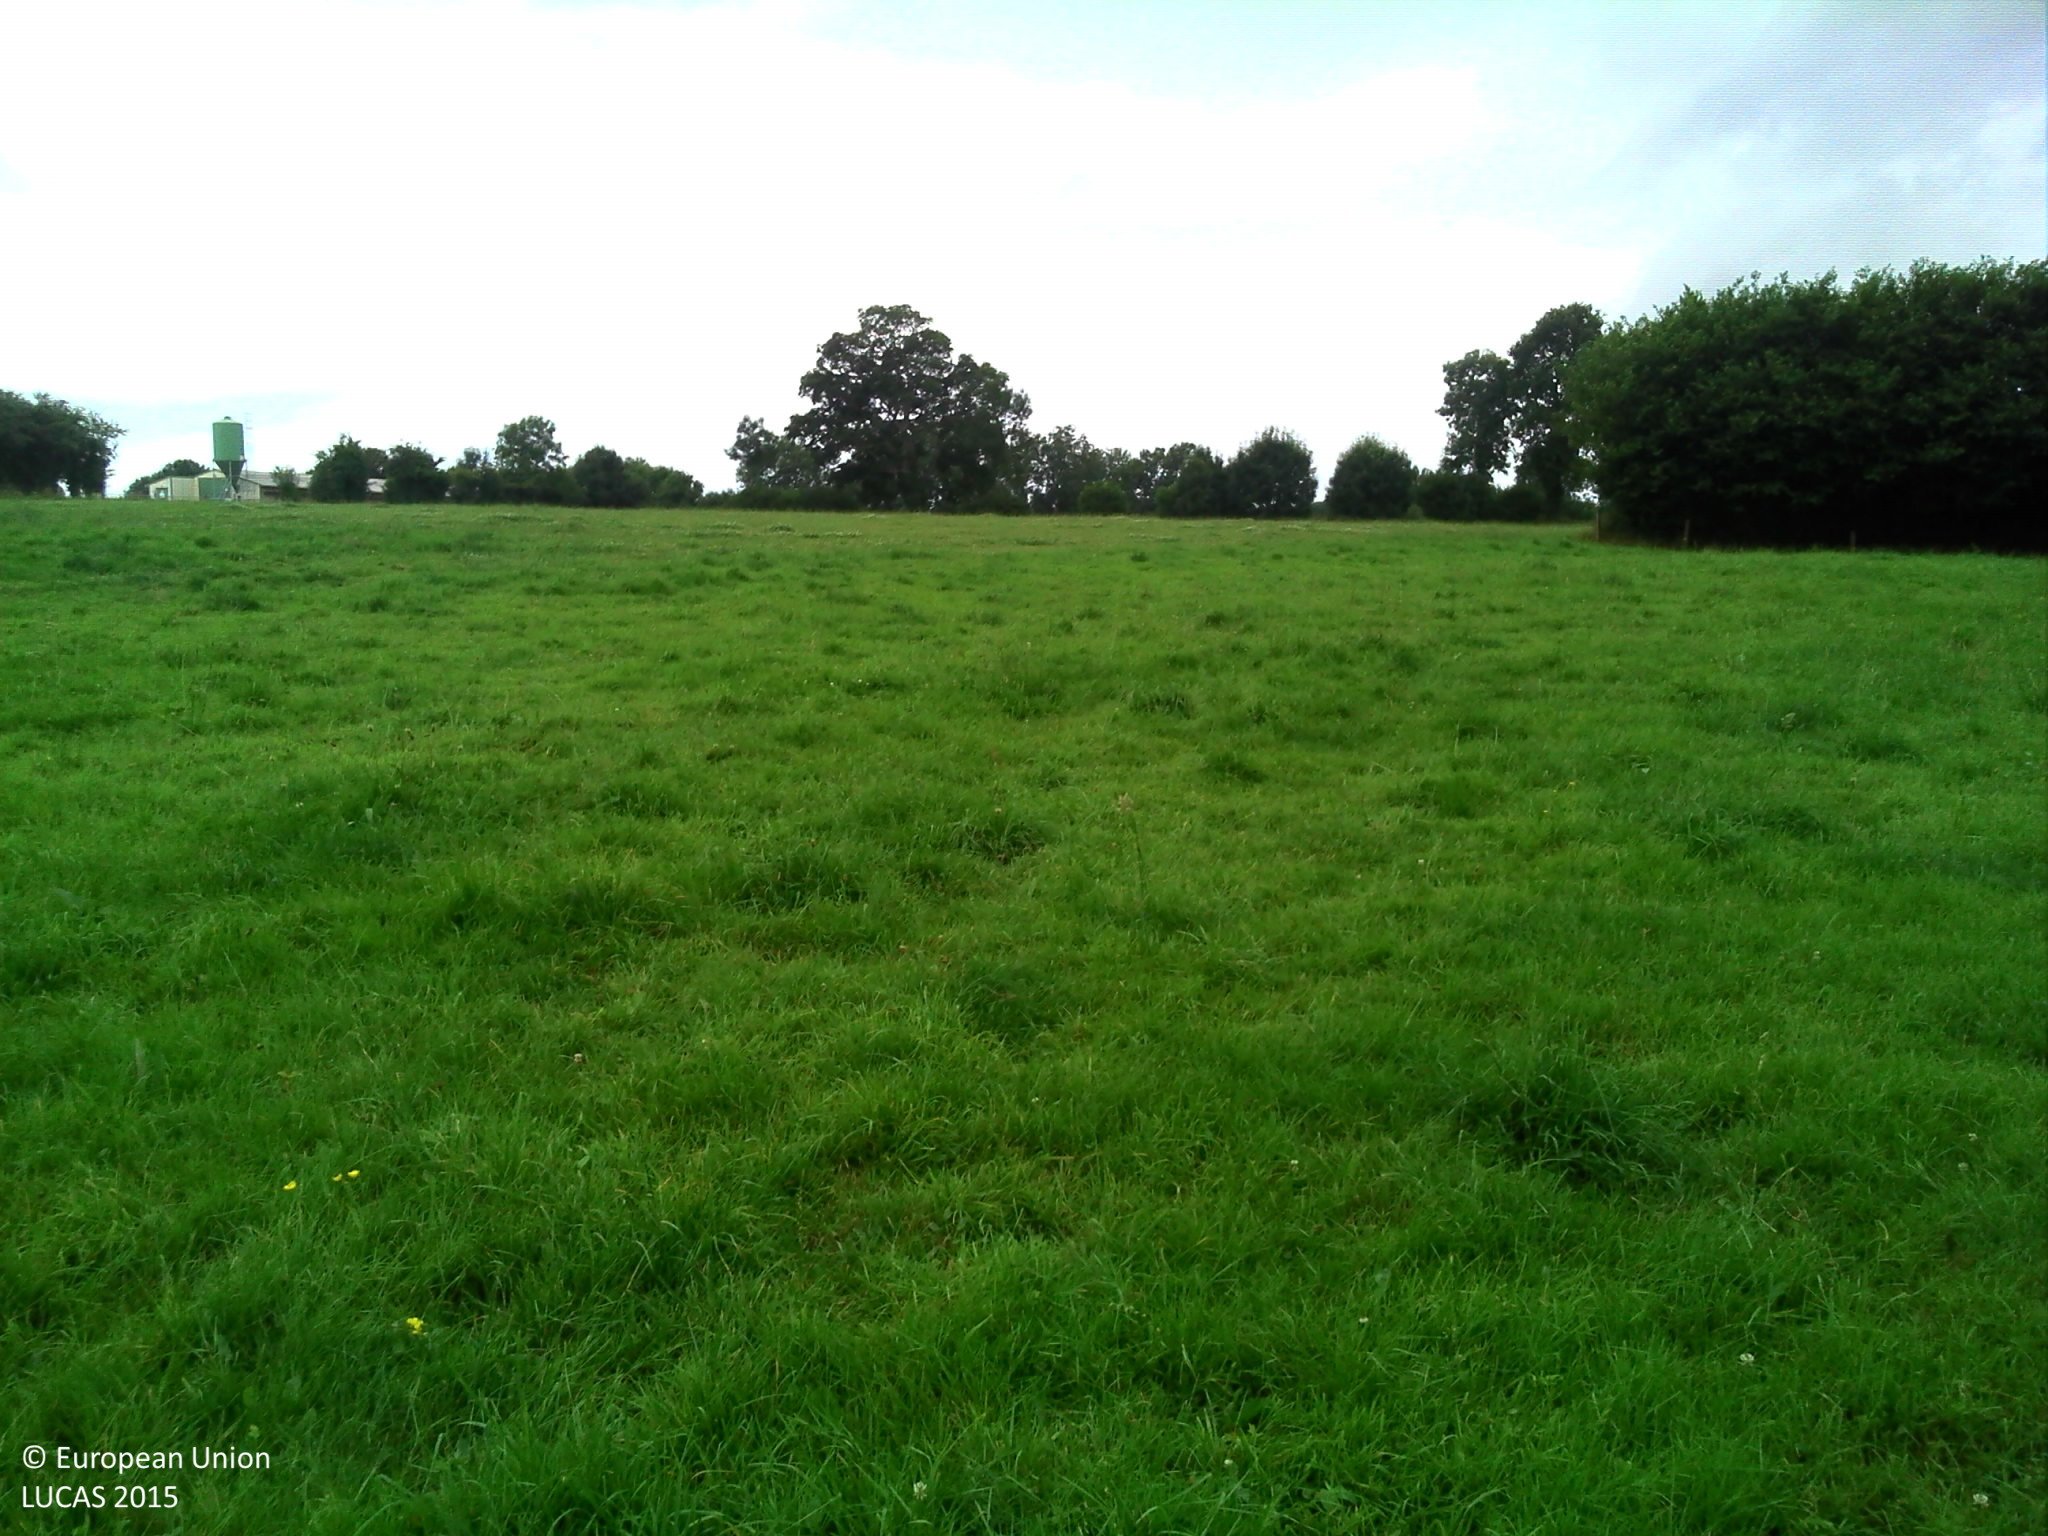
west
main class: Grassland
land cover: Grassland without tree/shrub cover
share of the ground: > 75 %
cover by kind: herbaceous plants 100 %
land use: Agriculture (excluding fallow land and kitchen gardens)
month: July
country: FR
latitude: 48.8298
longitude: -1.3940
